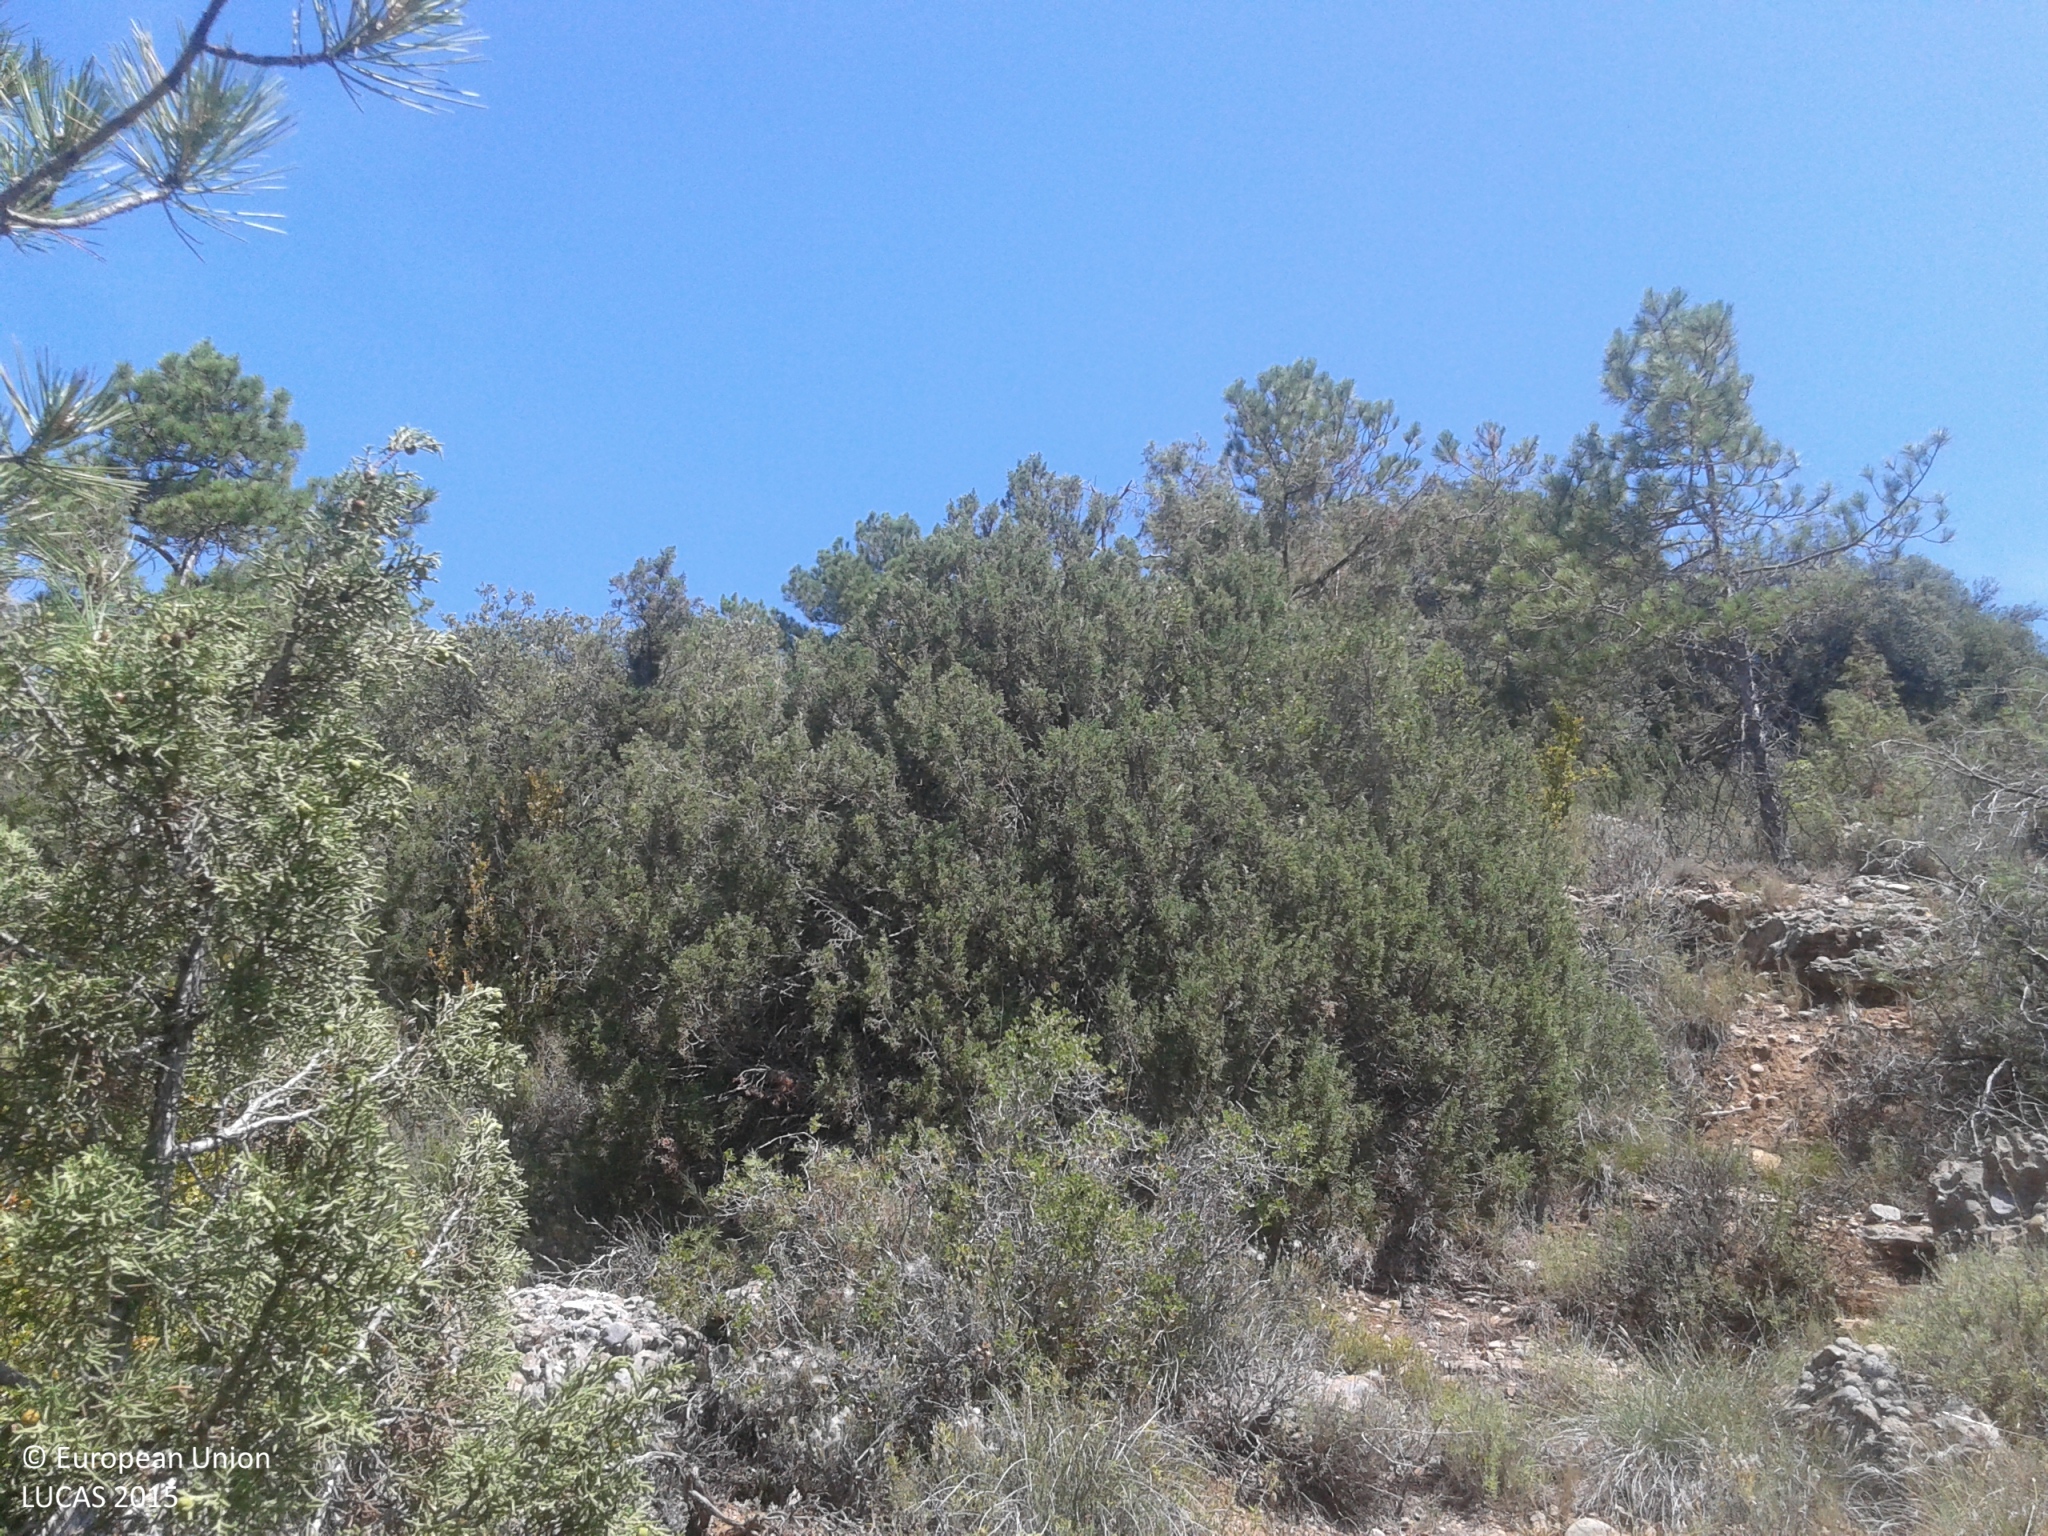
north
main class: Woodland
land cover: Other mixed woodland
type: coniferous forest of the mediterranean region
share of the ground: 25 - 50 %
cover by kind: shrubs 40 %, consolidated bare surface 20 %, coniferous forest trees 15 %, broadleaved forest trees 15 %, herbaceous plants 10 %
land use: Semi-natural and natural areas not in use
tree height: > 5 m
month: July
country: ES
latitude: 42.0284
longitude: 1.1335
